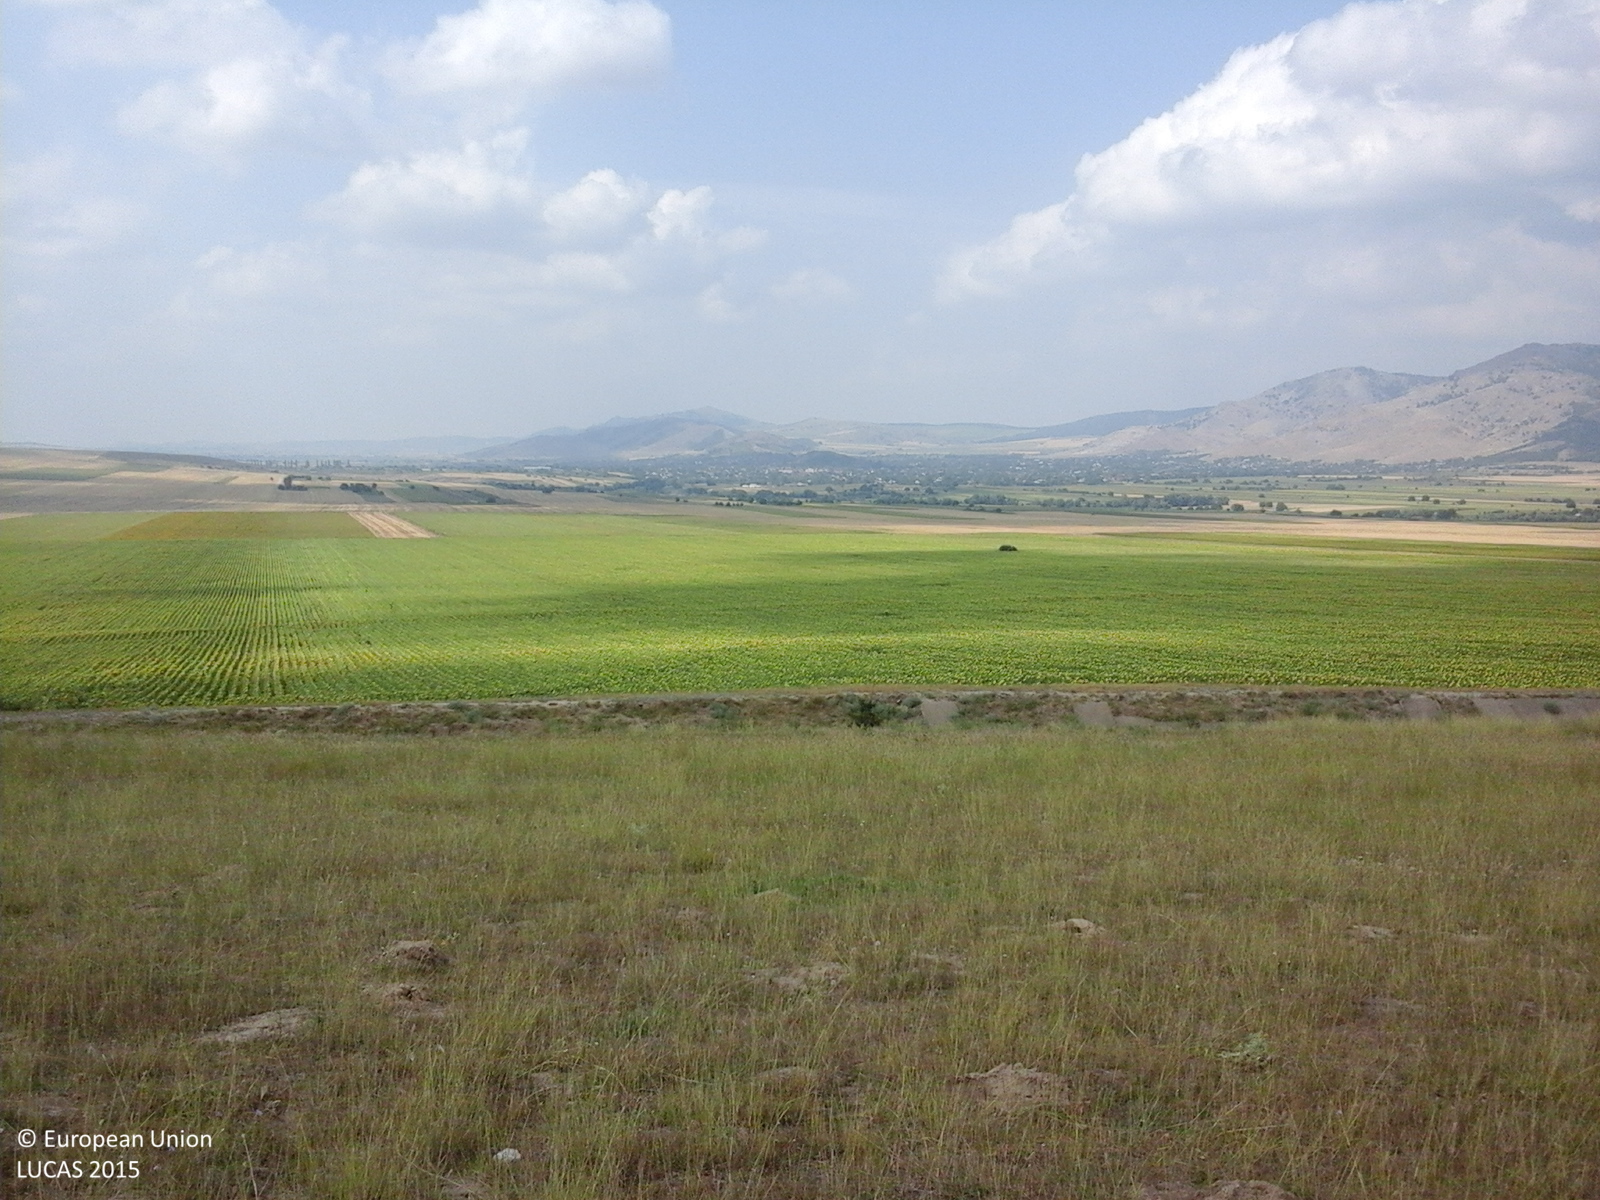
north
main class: Grassland
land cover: Grassland without tree/shrub cover
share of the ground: > 75 %
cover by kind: herbaceous plants 100 %
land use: Agriculture (excluding fallow land and kitchen gardens)
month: July
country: RO
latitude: 45.1516
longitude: 28.2474
